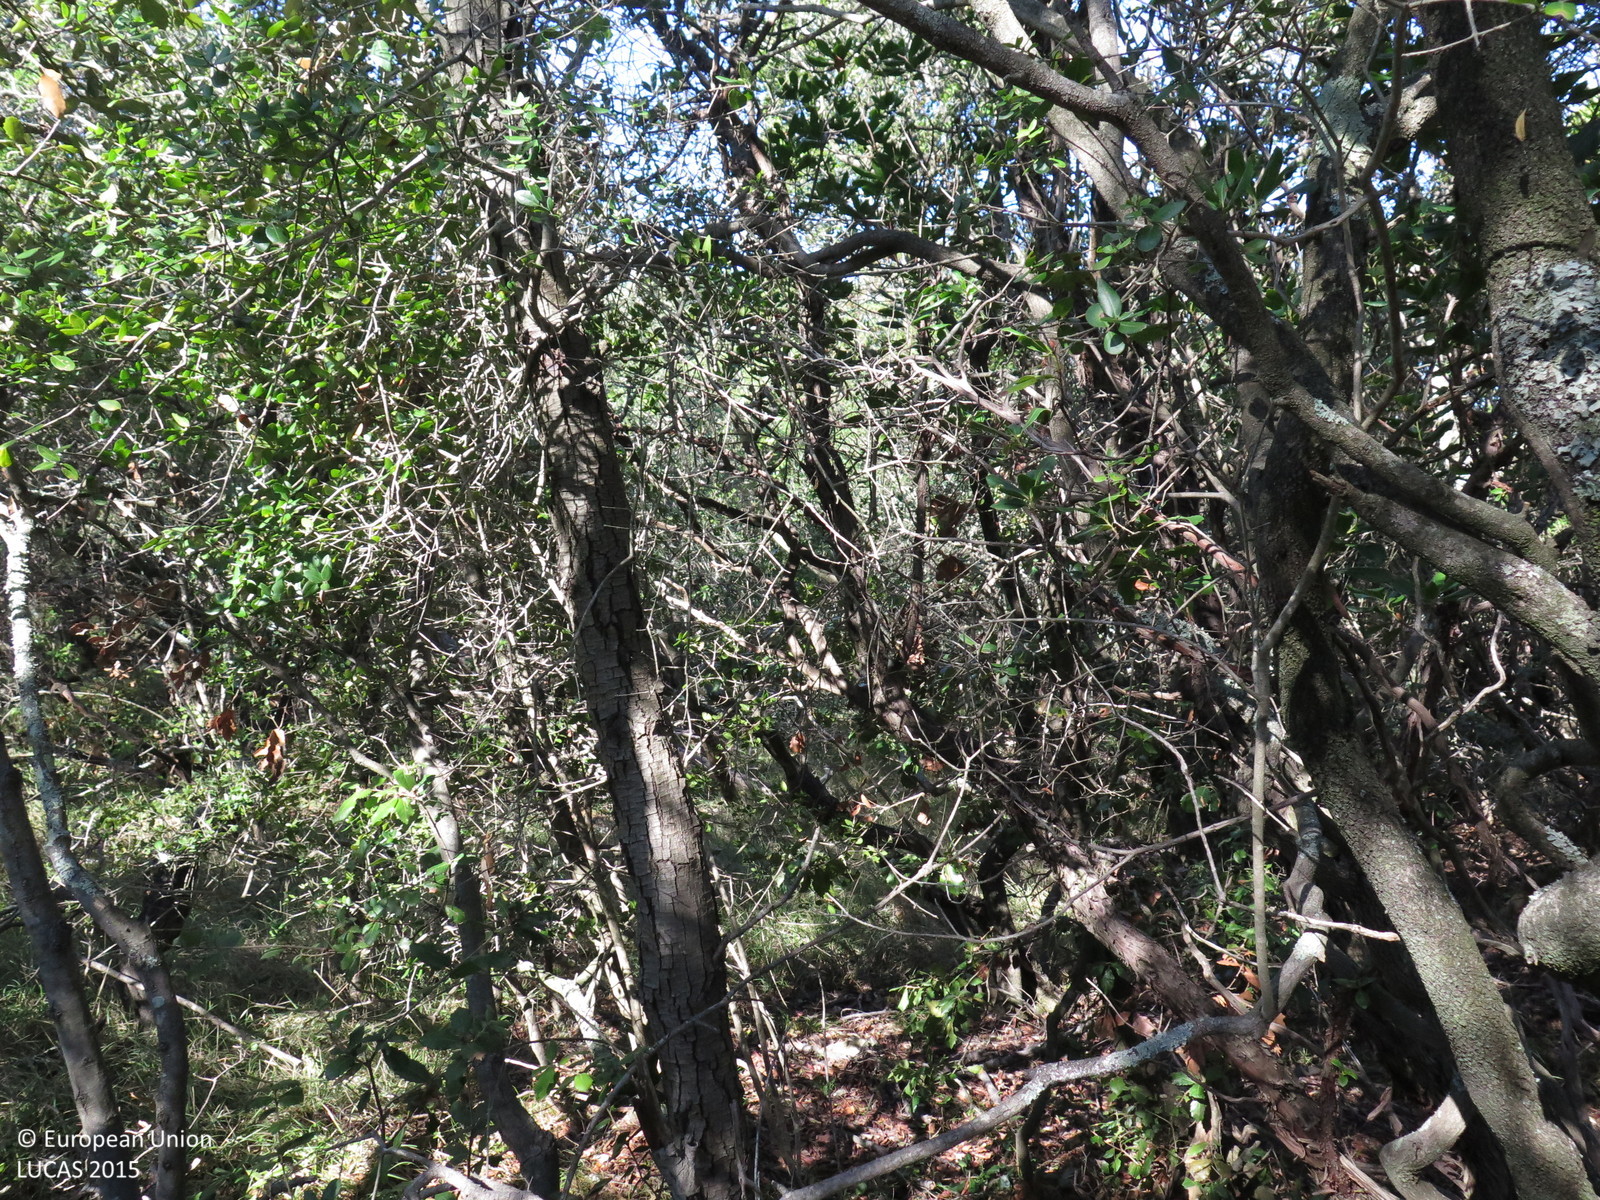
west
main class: Woodland
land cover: Broadleaved woodland
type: thermophilous deciduous forest
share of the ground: > 75 %
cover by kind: broadleaved forest trees 90 %, shrubs 5 %, herbaceous plants 5 %
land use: Semi-natural and natural areas not in use
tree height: > 5 m
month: September
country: HR
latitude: 44.5828
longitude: 14.3888
